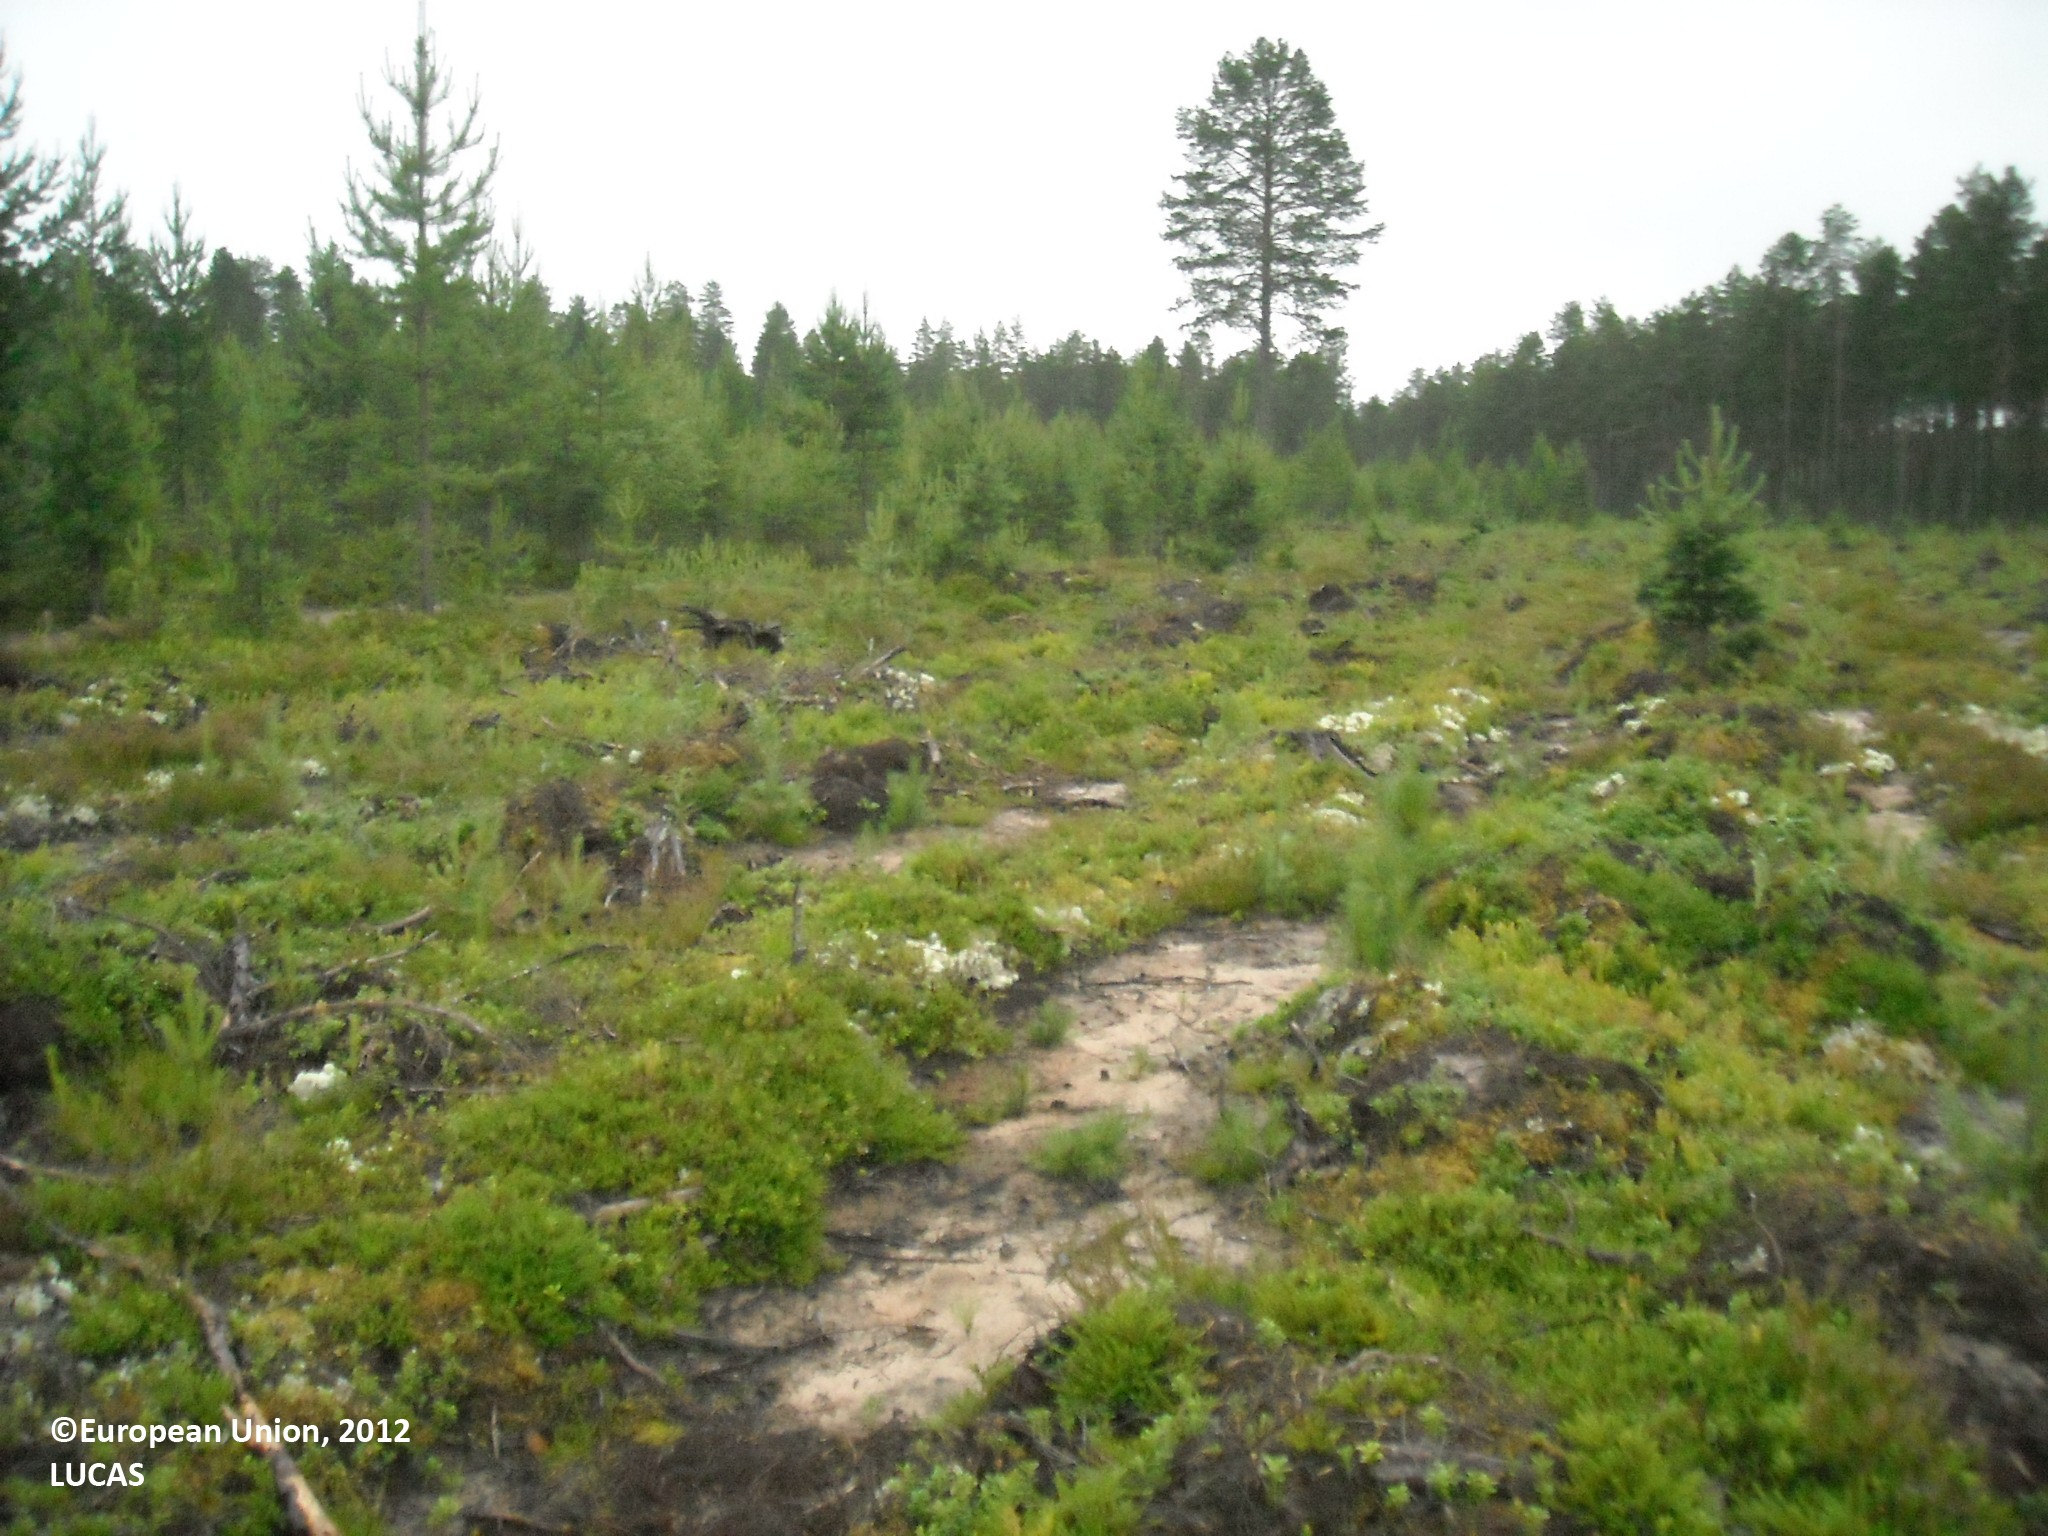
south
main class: Shrubland
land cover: Shrubland with sparse tree cover
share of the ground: > 75 %
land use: Forestry
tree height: < 5 m
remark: Clear cut
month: July
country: FI
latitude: 64.4040
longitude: 27.1239
